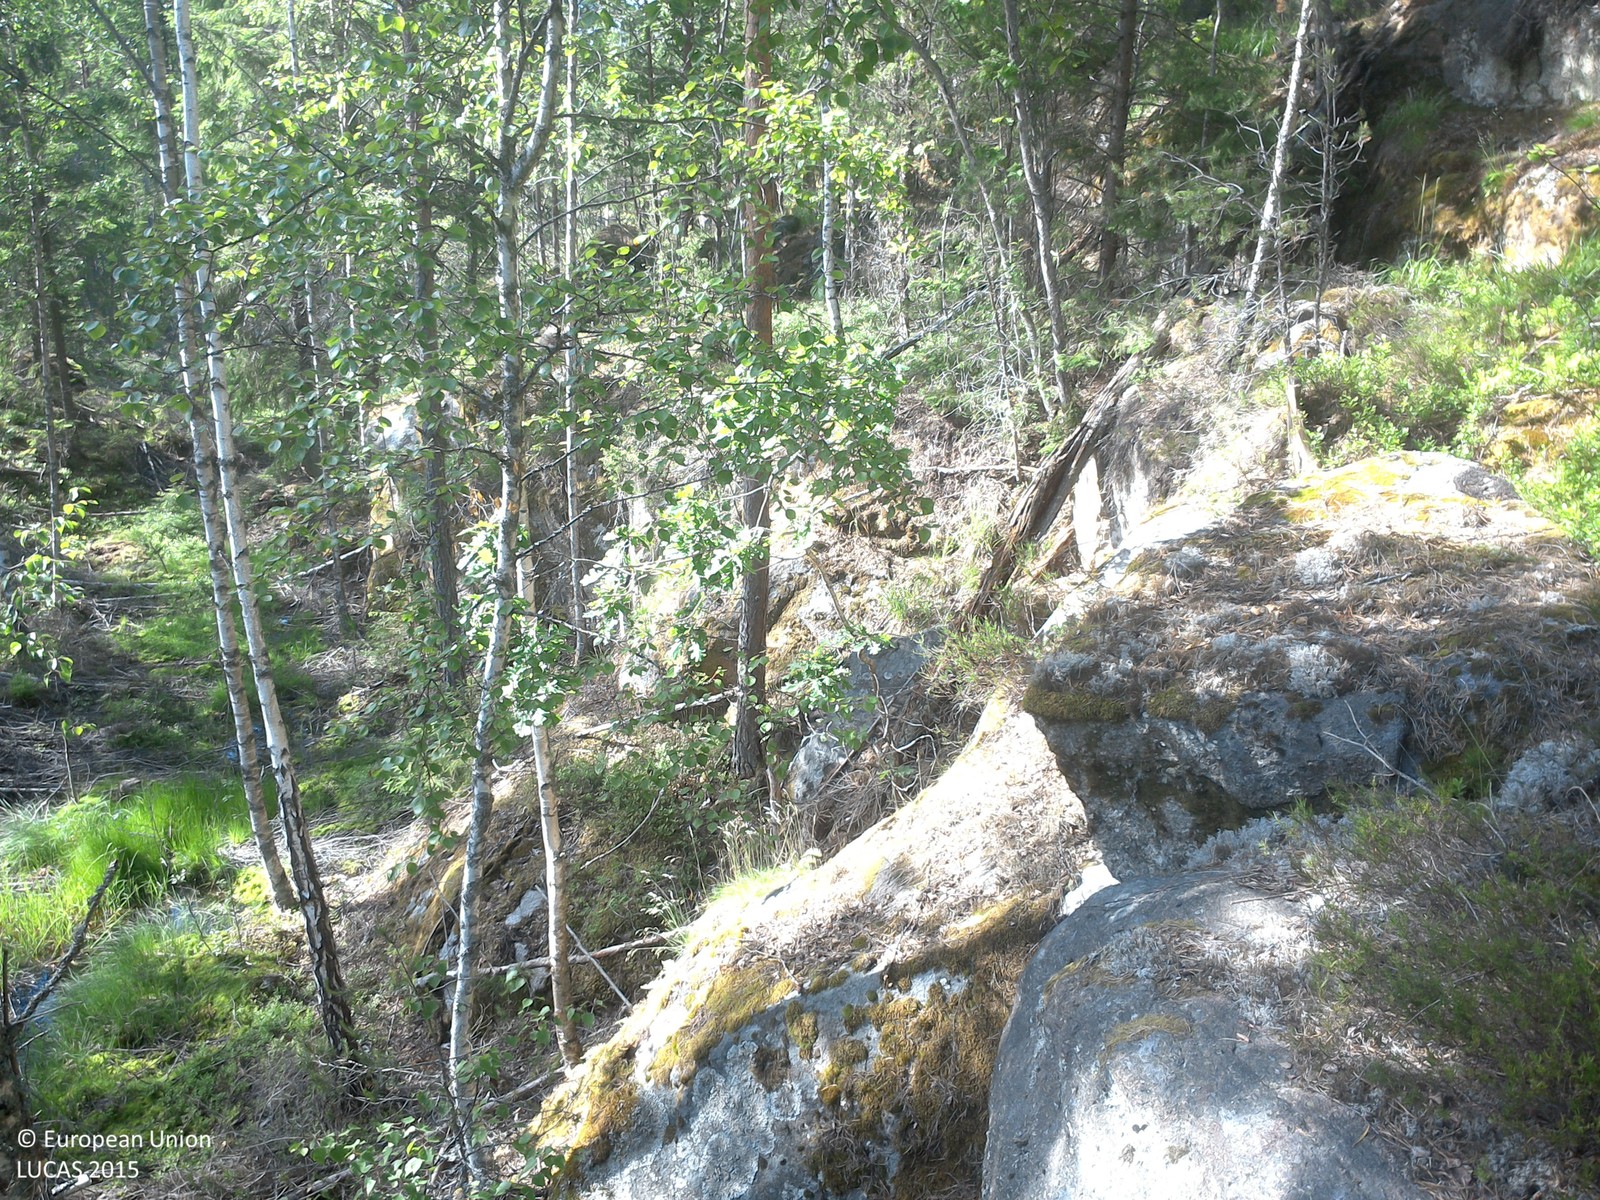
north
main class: Woodland
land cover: Pine dominated mixed woodland
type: boreal forest
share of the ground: > 75 %
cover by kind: coniferous forest trees 60 %, broadleaved forest trees 20 %, herbaceous plants 10 %, lichens and mosses 10 %
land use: Forestry
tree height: > 5 m
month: June
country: SE
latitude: 58.0264
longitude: 15.7018
